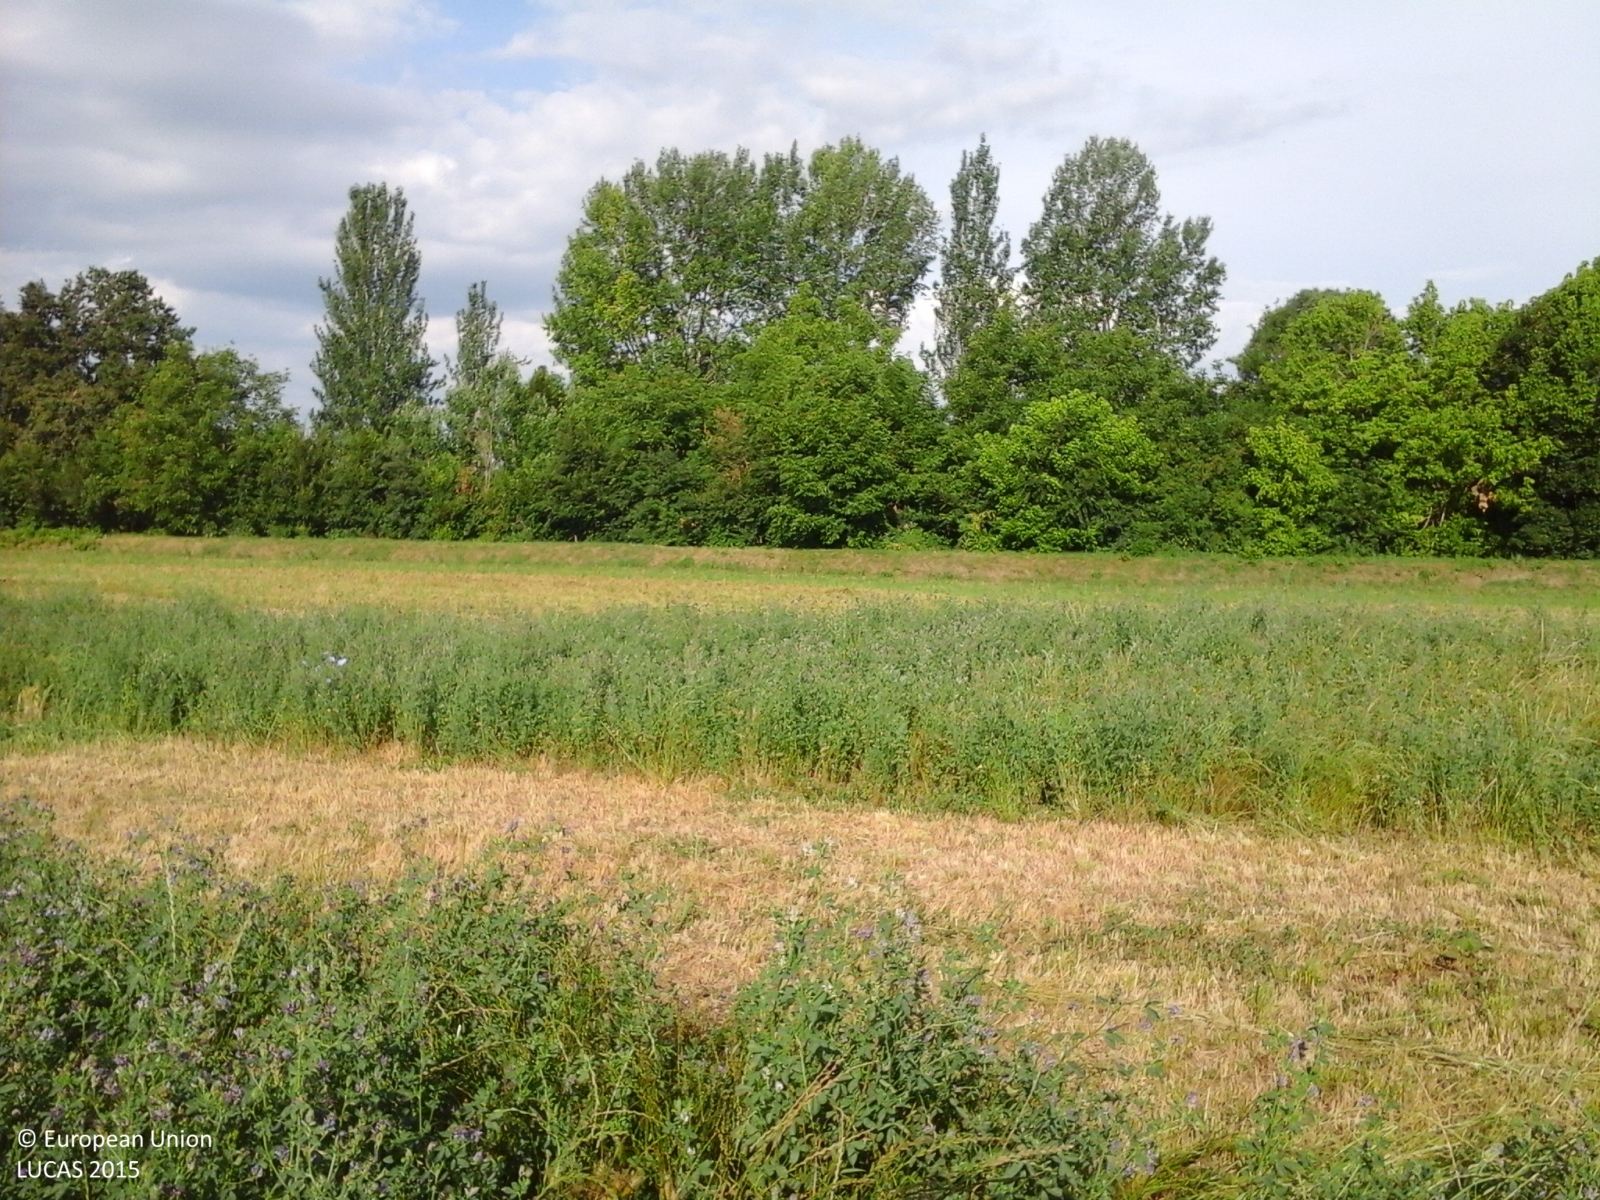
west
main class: Cropland
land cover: Lucerne
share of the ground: > 75 %
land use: Agriculture (excluding fallow land and kitchen gardens)
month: June
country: IT
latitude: 44.6915
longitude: 10.5918
